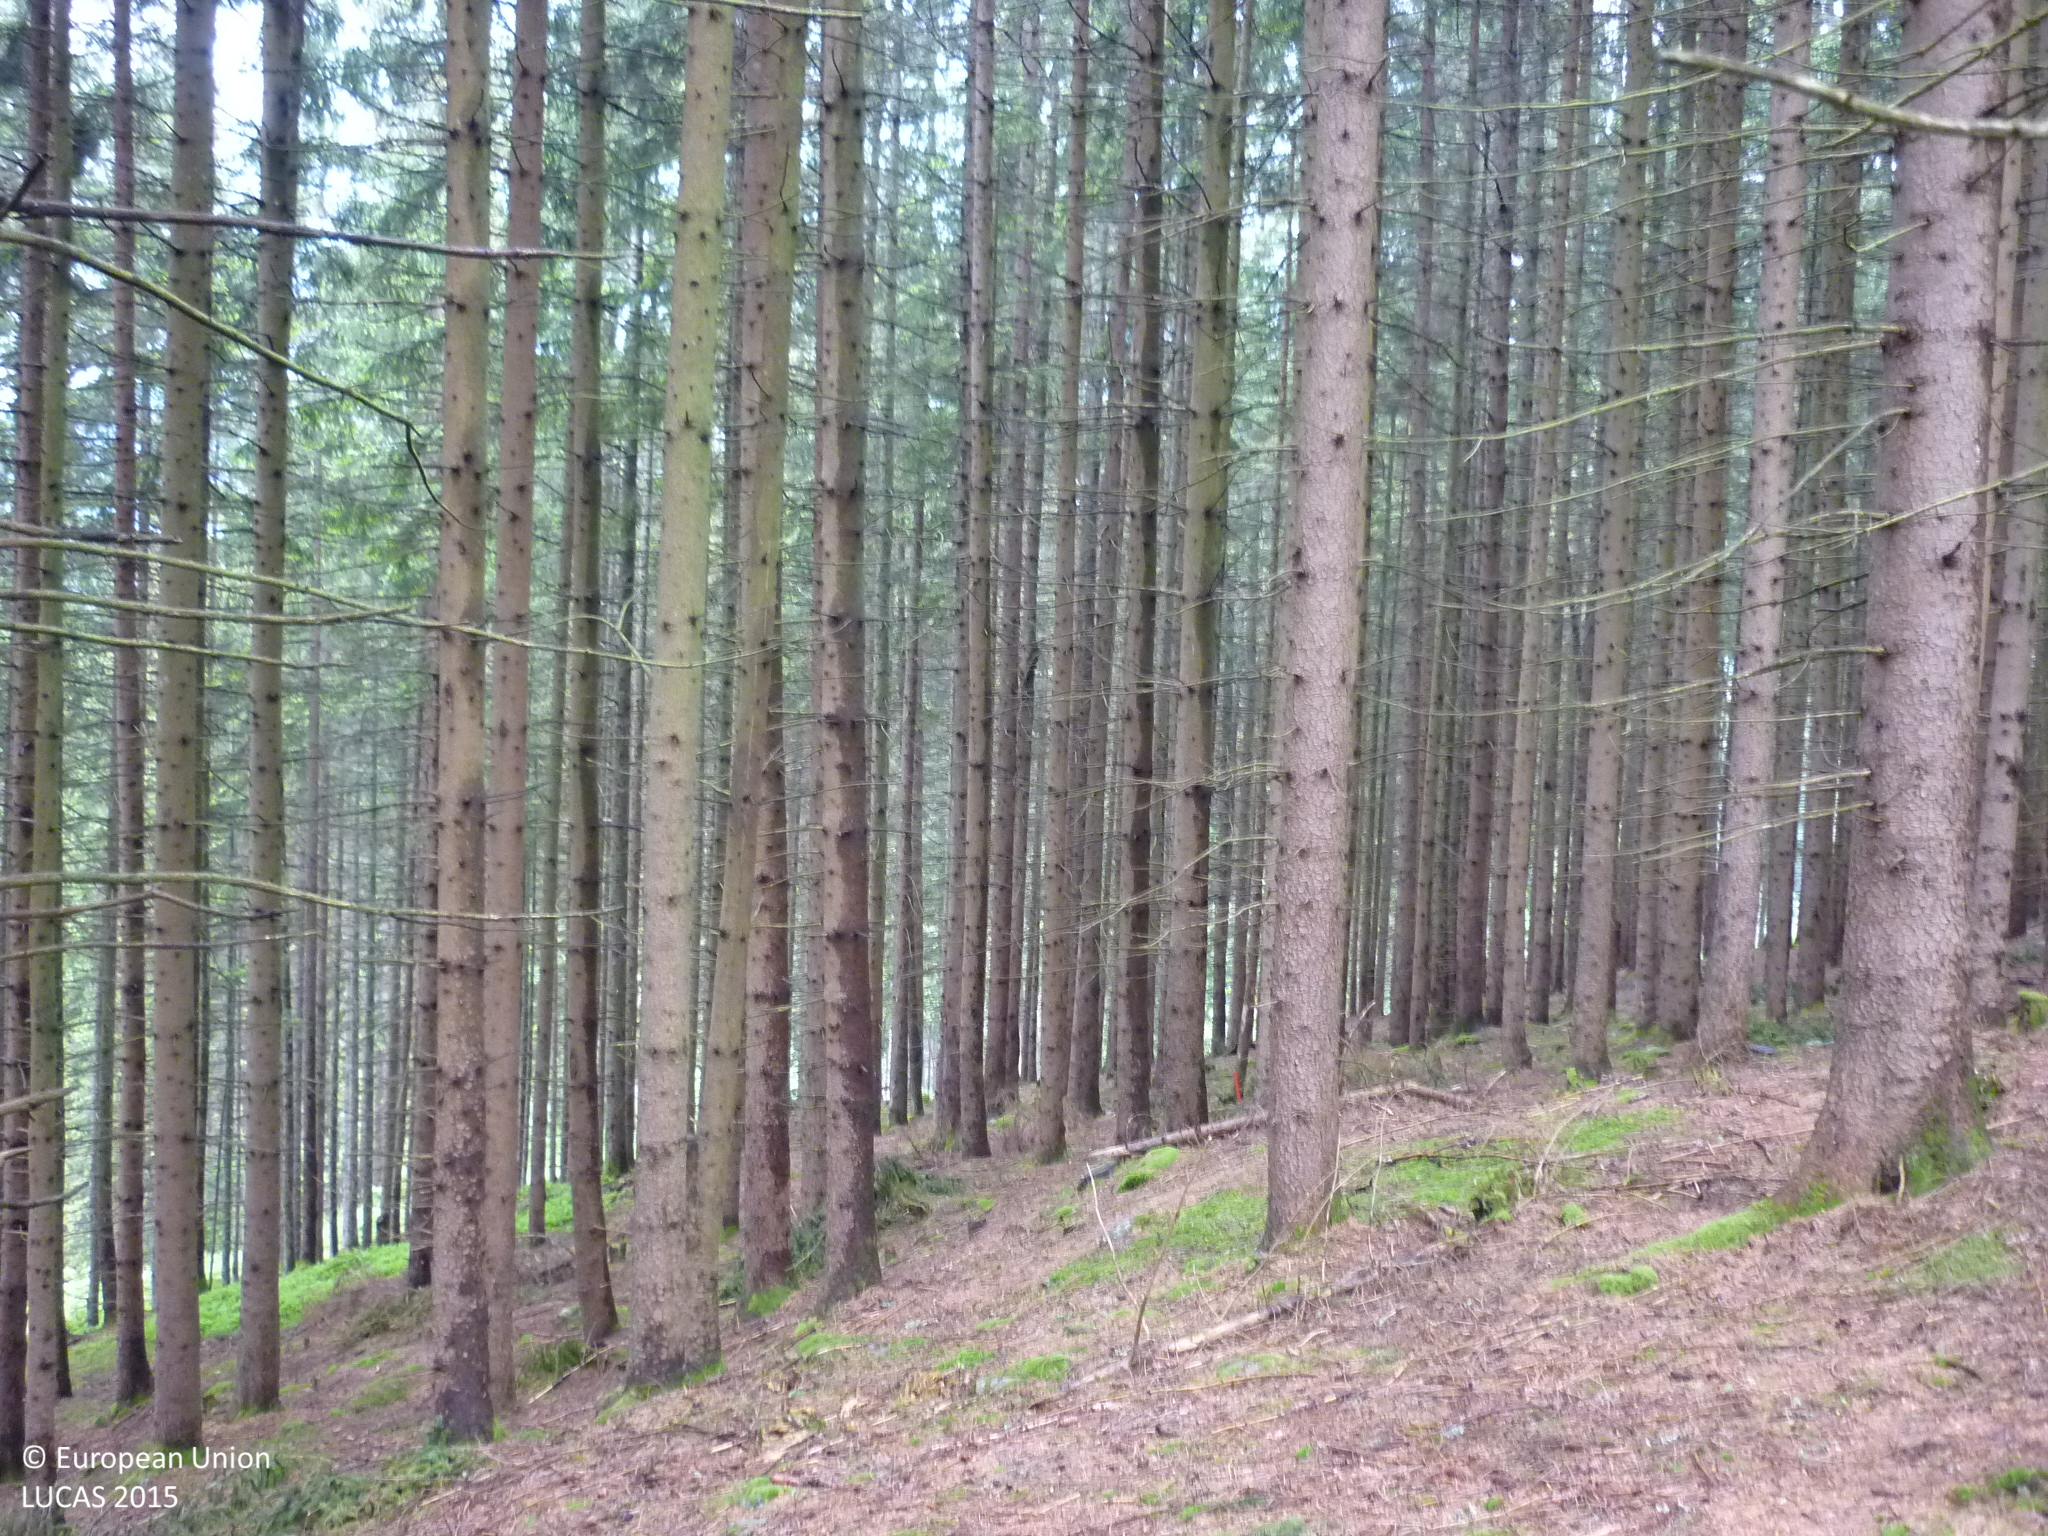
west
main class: Woodland
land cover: Spruce dominated coniferous woodland
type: alpine coniferous forest
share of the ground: > 75 %
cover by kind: coniferous forest trees 90 %, lichens and mosses 10 %
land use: Forestry
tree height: > 5 m
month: May
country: AT
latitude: 47.5961
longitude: 14.3747
